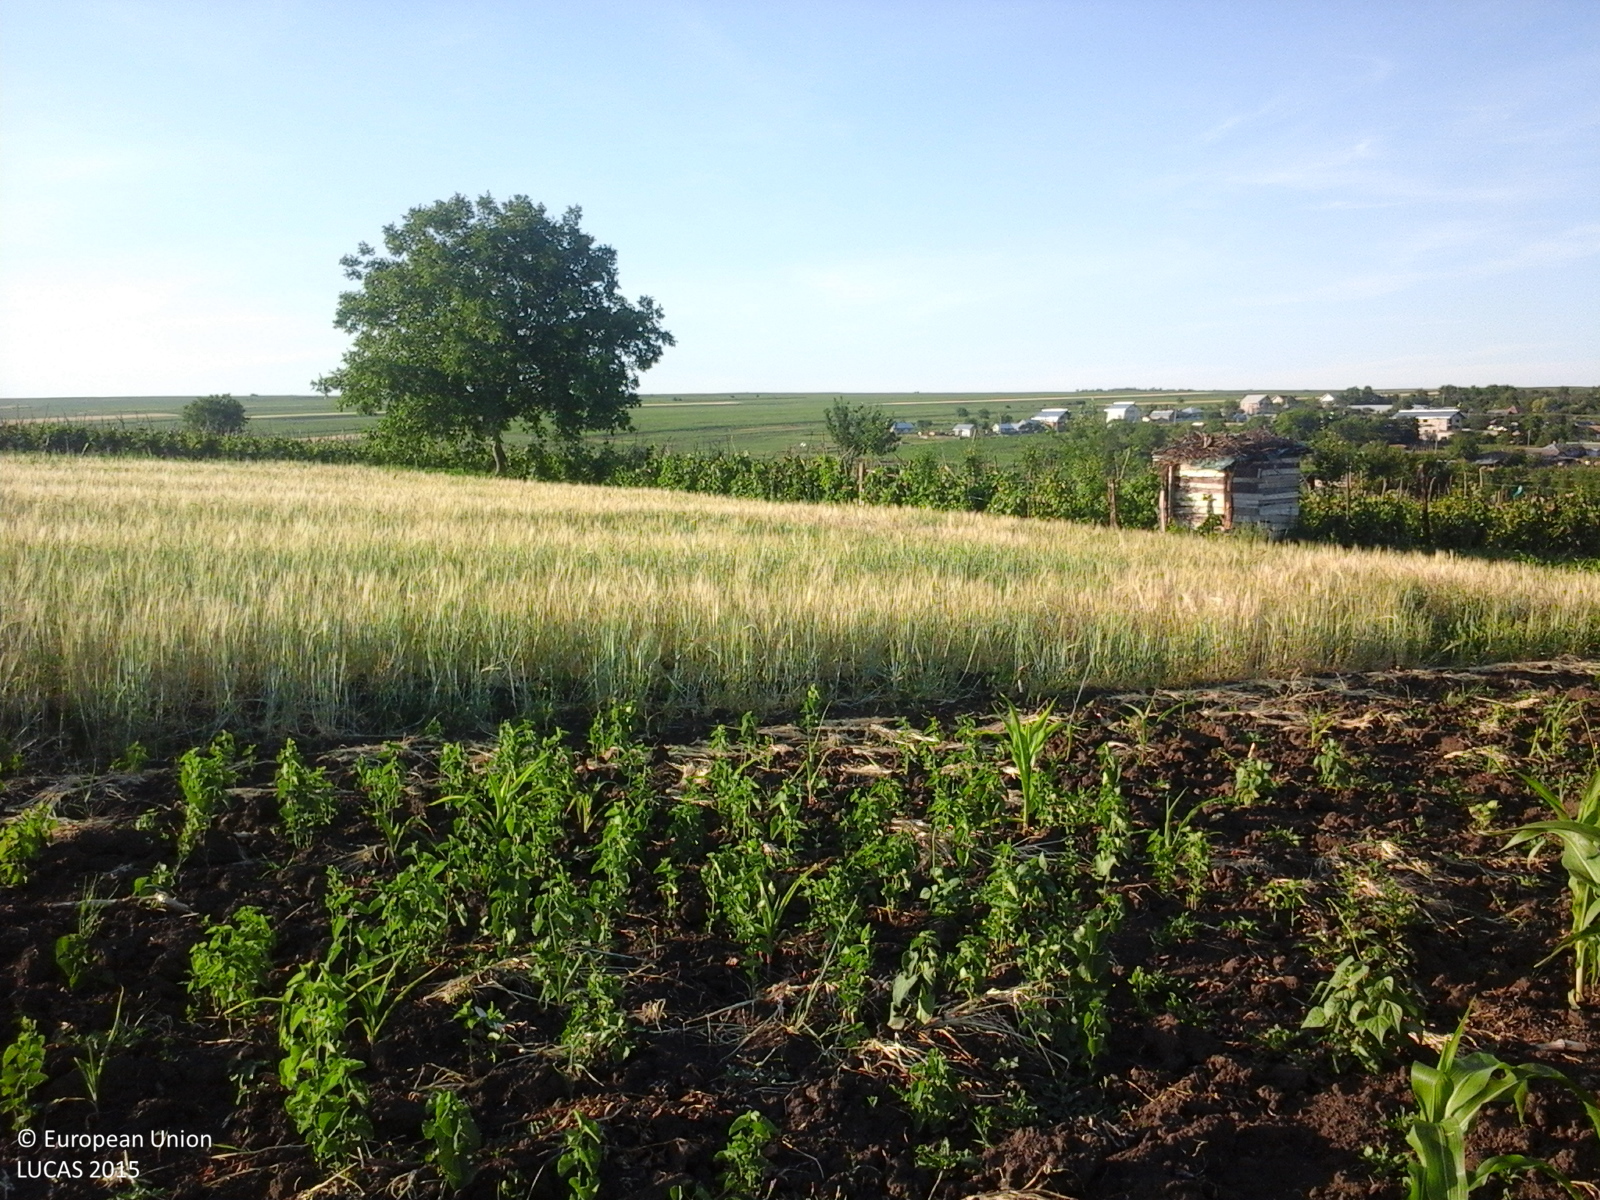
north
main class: Cropland
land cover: Maize
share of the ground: > 75 %
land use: Agriculture (excluding fallow land and kitchen gardens)
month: June
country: RO
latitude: 47.3190
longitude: 27.0782
